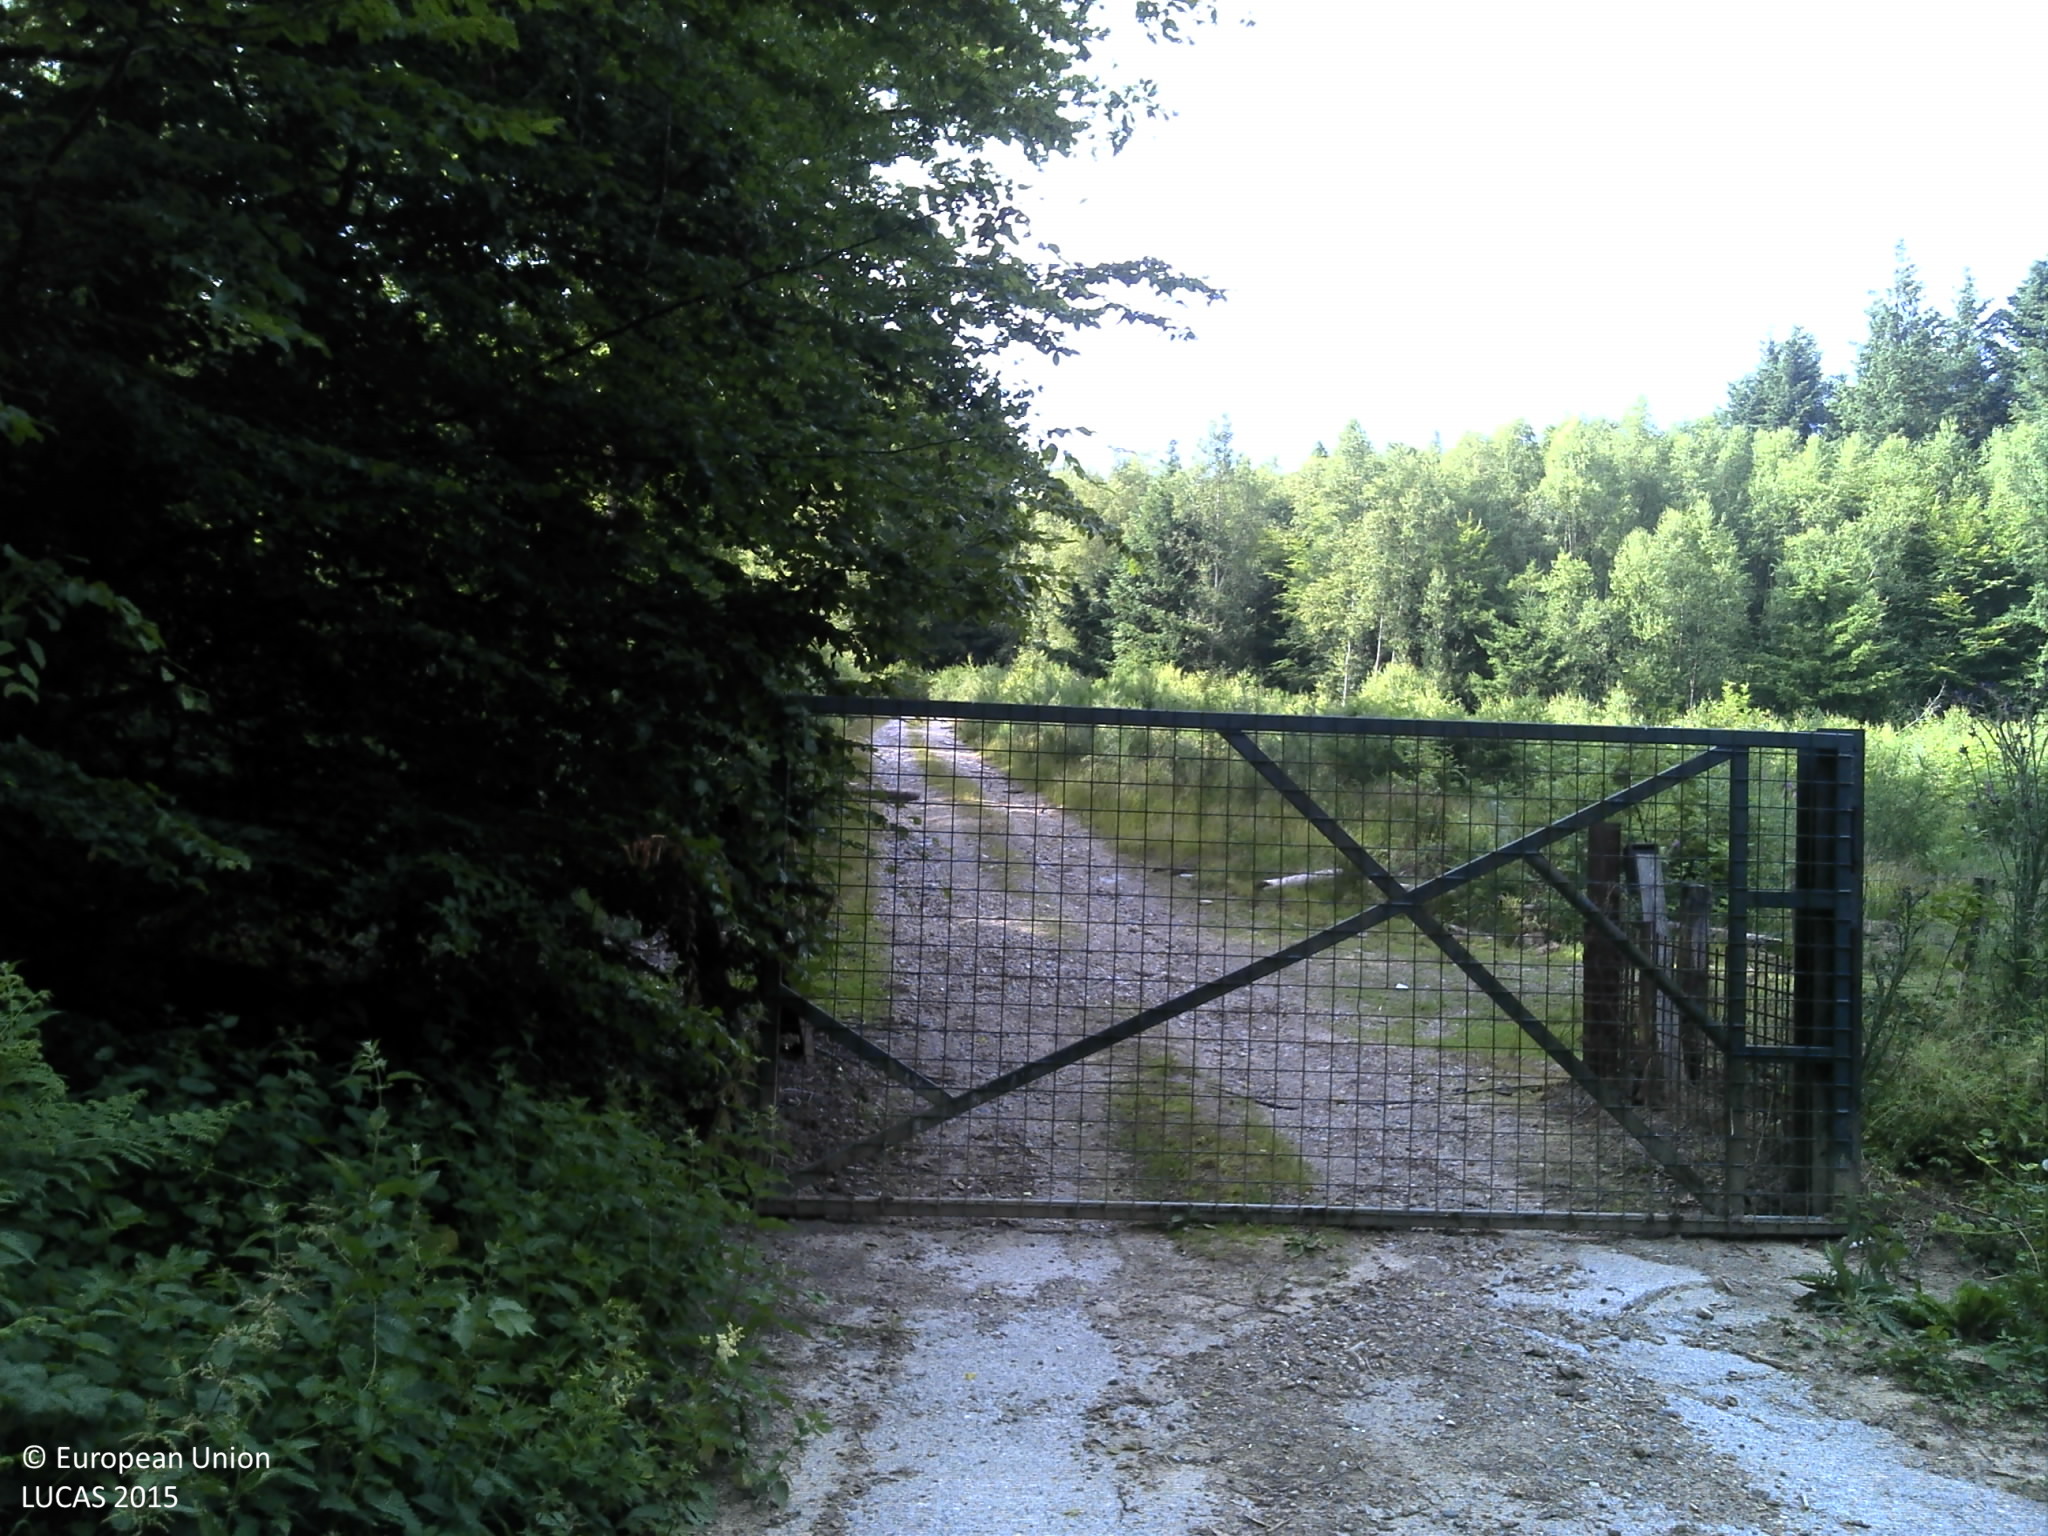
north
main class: Woodland
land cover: Spruce dominated coniferous woodland
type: mountainous beech forest
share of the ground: 25 - 50 %
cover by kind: coniferous forest trees 60 %, herbaceous plants 25 %, broadleaved forest trees 10 %, lichens and mosses 5 %
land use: Forestry
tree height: > 5 m
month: June
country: FR
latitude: 49.8919
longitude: 4.5535
